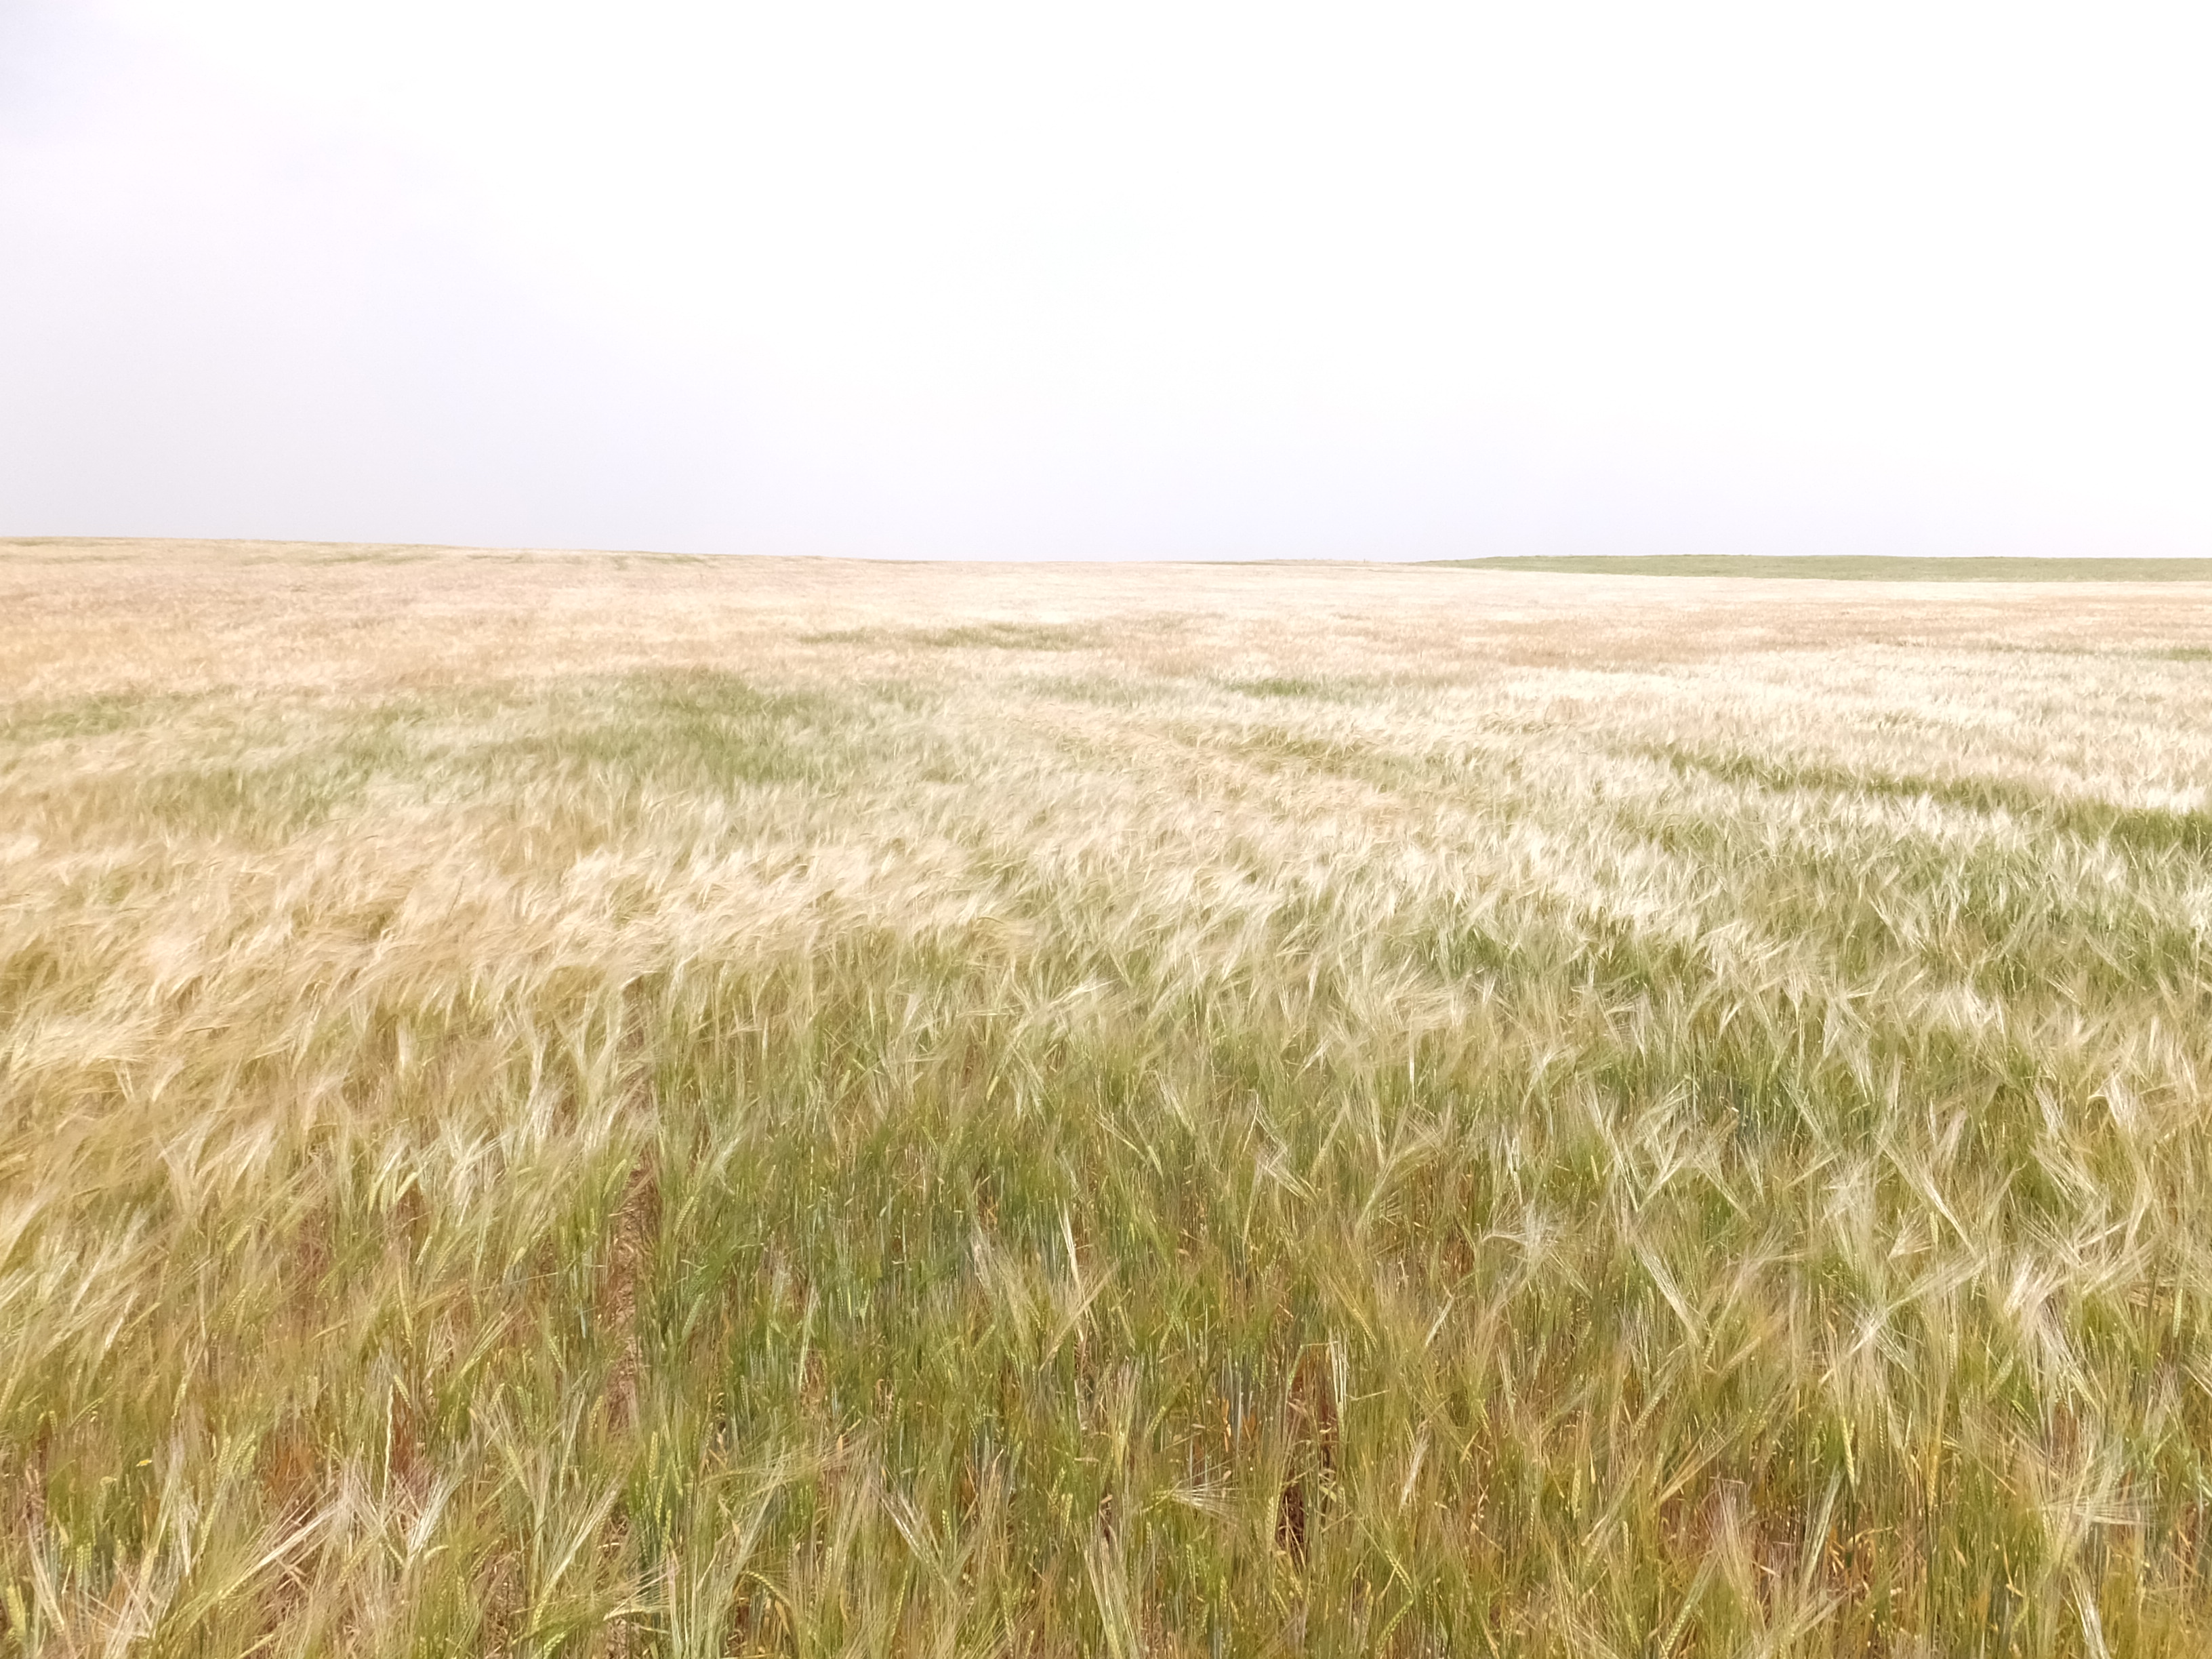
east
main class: Cropland
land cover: Barley
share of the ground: > 75 %
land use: Agriculture (excluding fallow land and kitchen gardens)
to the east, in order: Barley
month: May
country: ES
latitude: 41.4177
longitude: -0.1245
